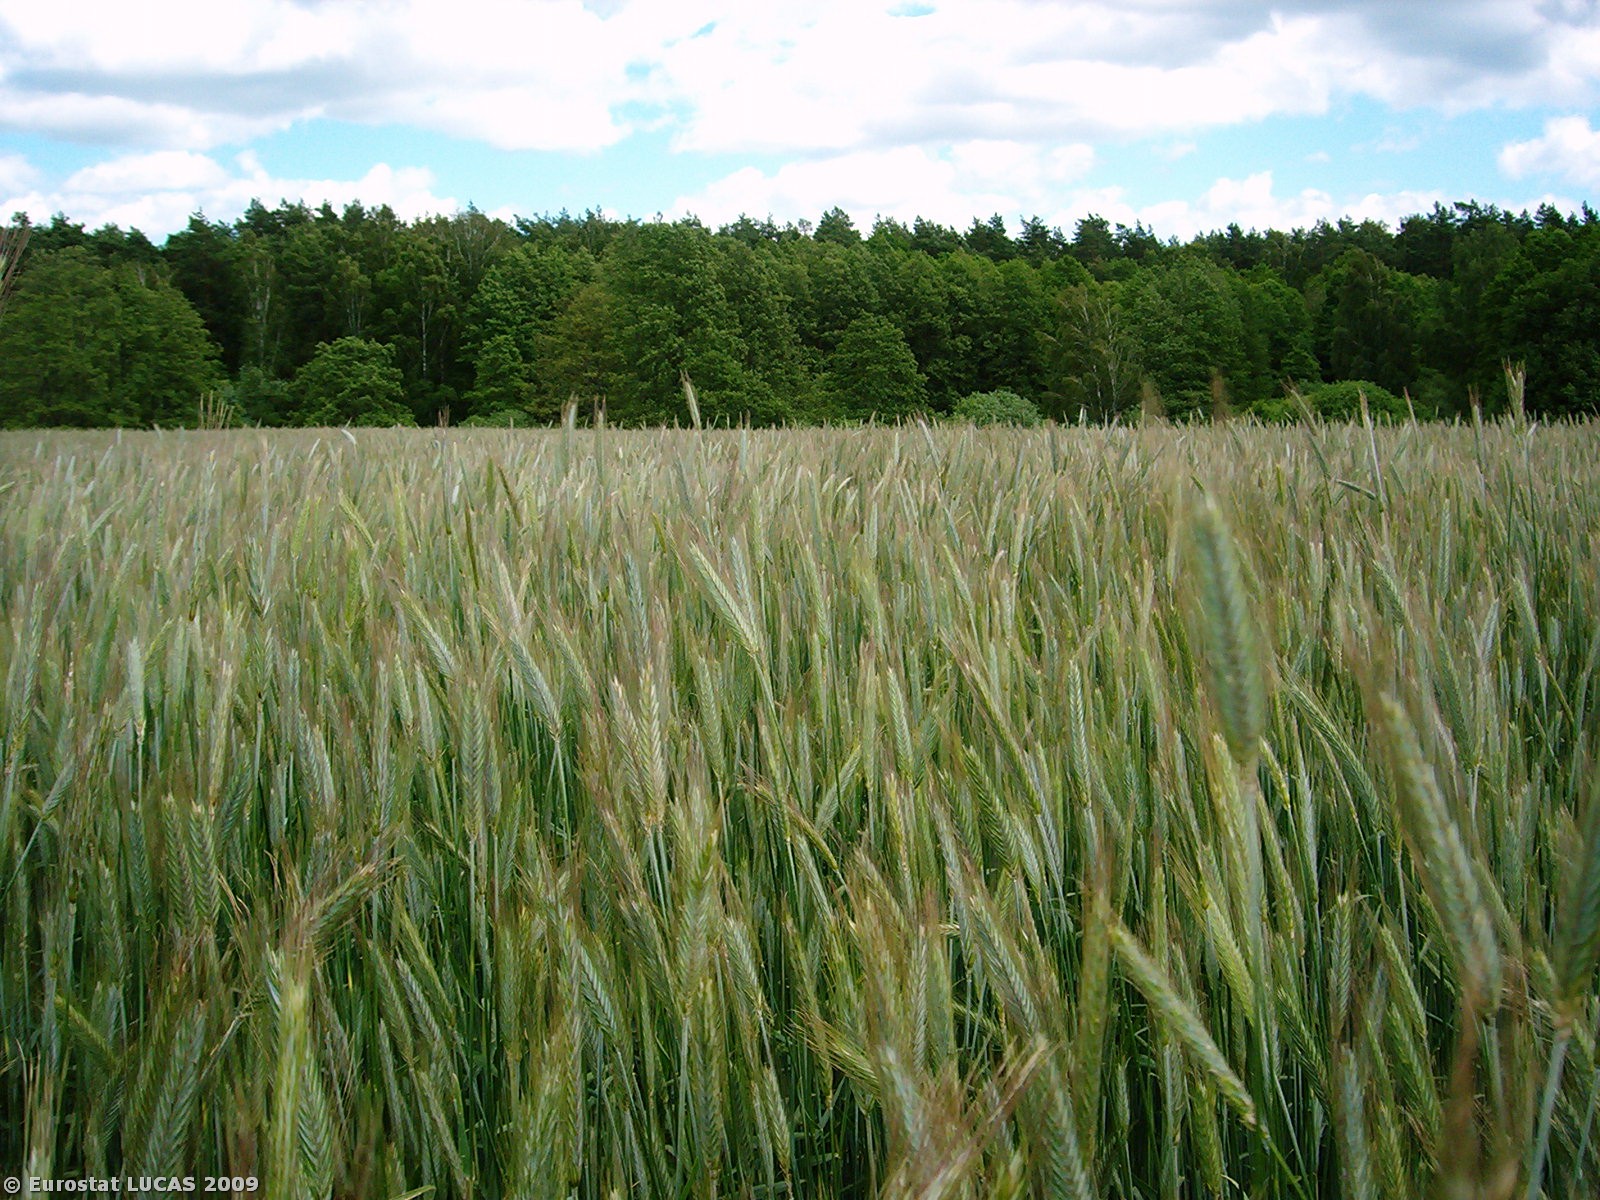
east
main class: Cropland
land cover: Rye
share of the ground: > 75 %
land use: Agriculture (excluding fallow land and kitchen gardens)
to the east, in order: Rye; Shrubland with sparse tree cover; Rivers and streams; Shrubland with sparse tree cover; Mixed woodland
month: June
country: PL
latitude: 53.5873
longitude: 17.1551
